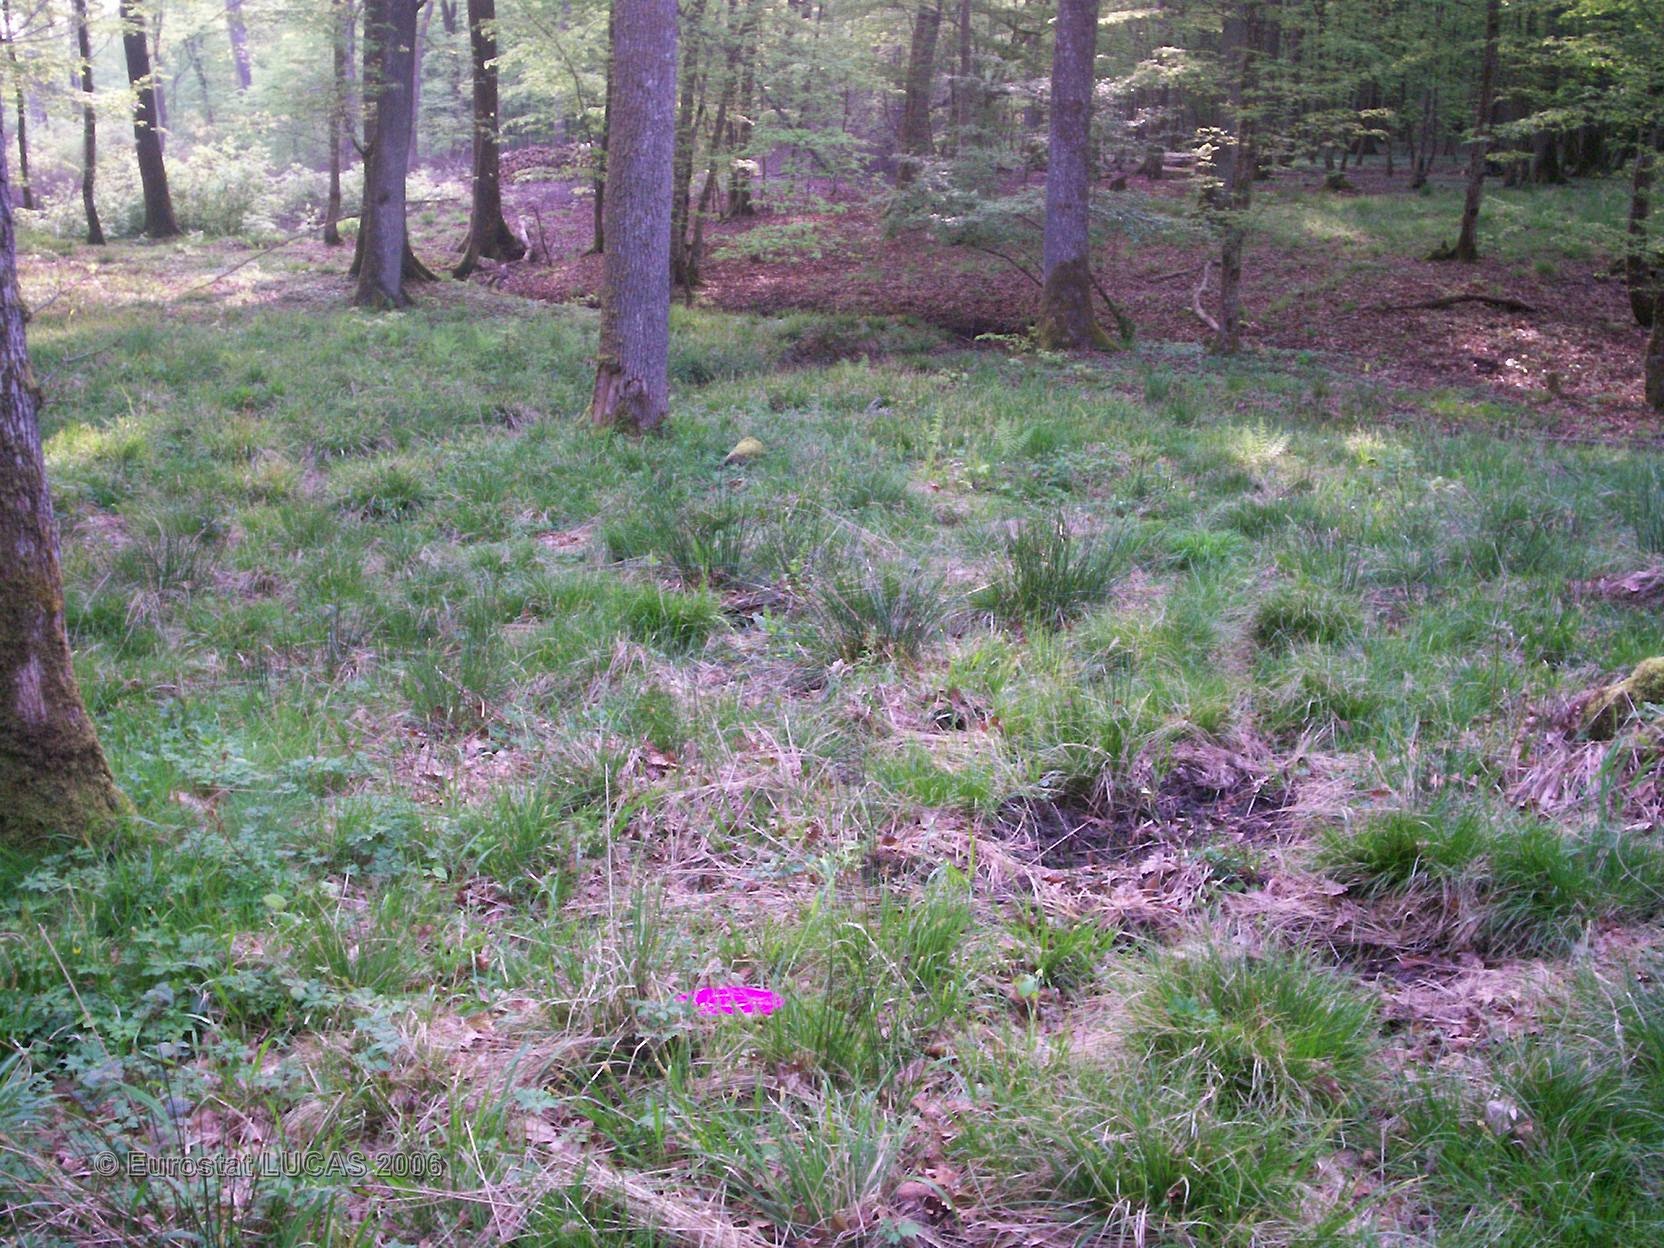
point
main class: Woodland
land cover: Broadleaved forest
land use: Forestry
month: May
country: FR
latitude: 48.9744
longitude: 6.9812
